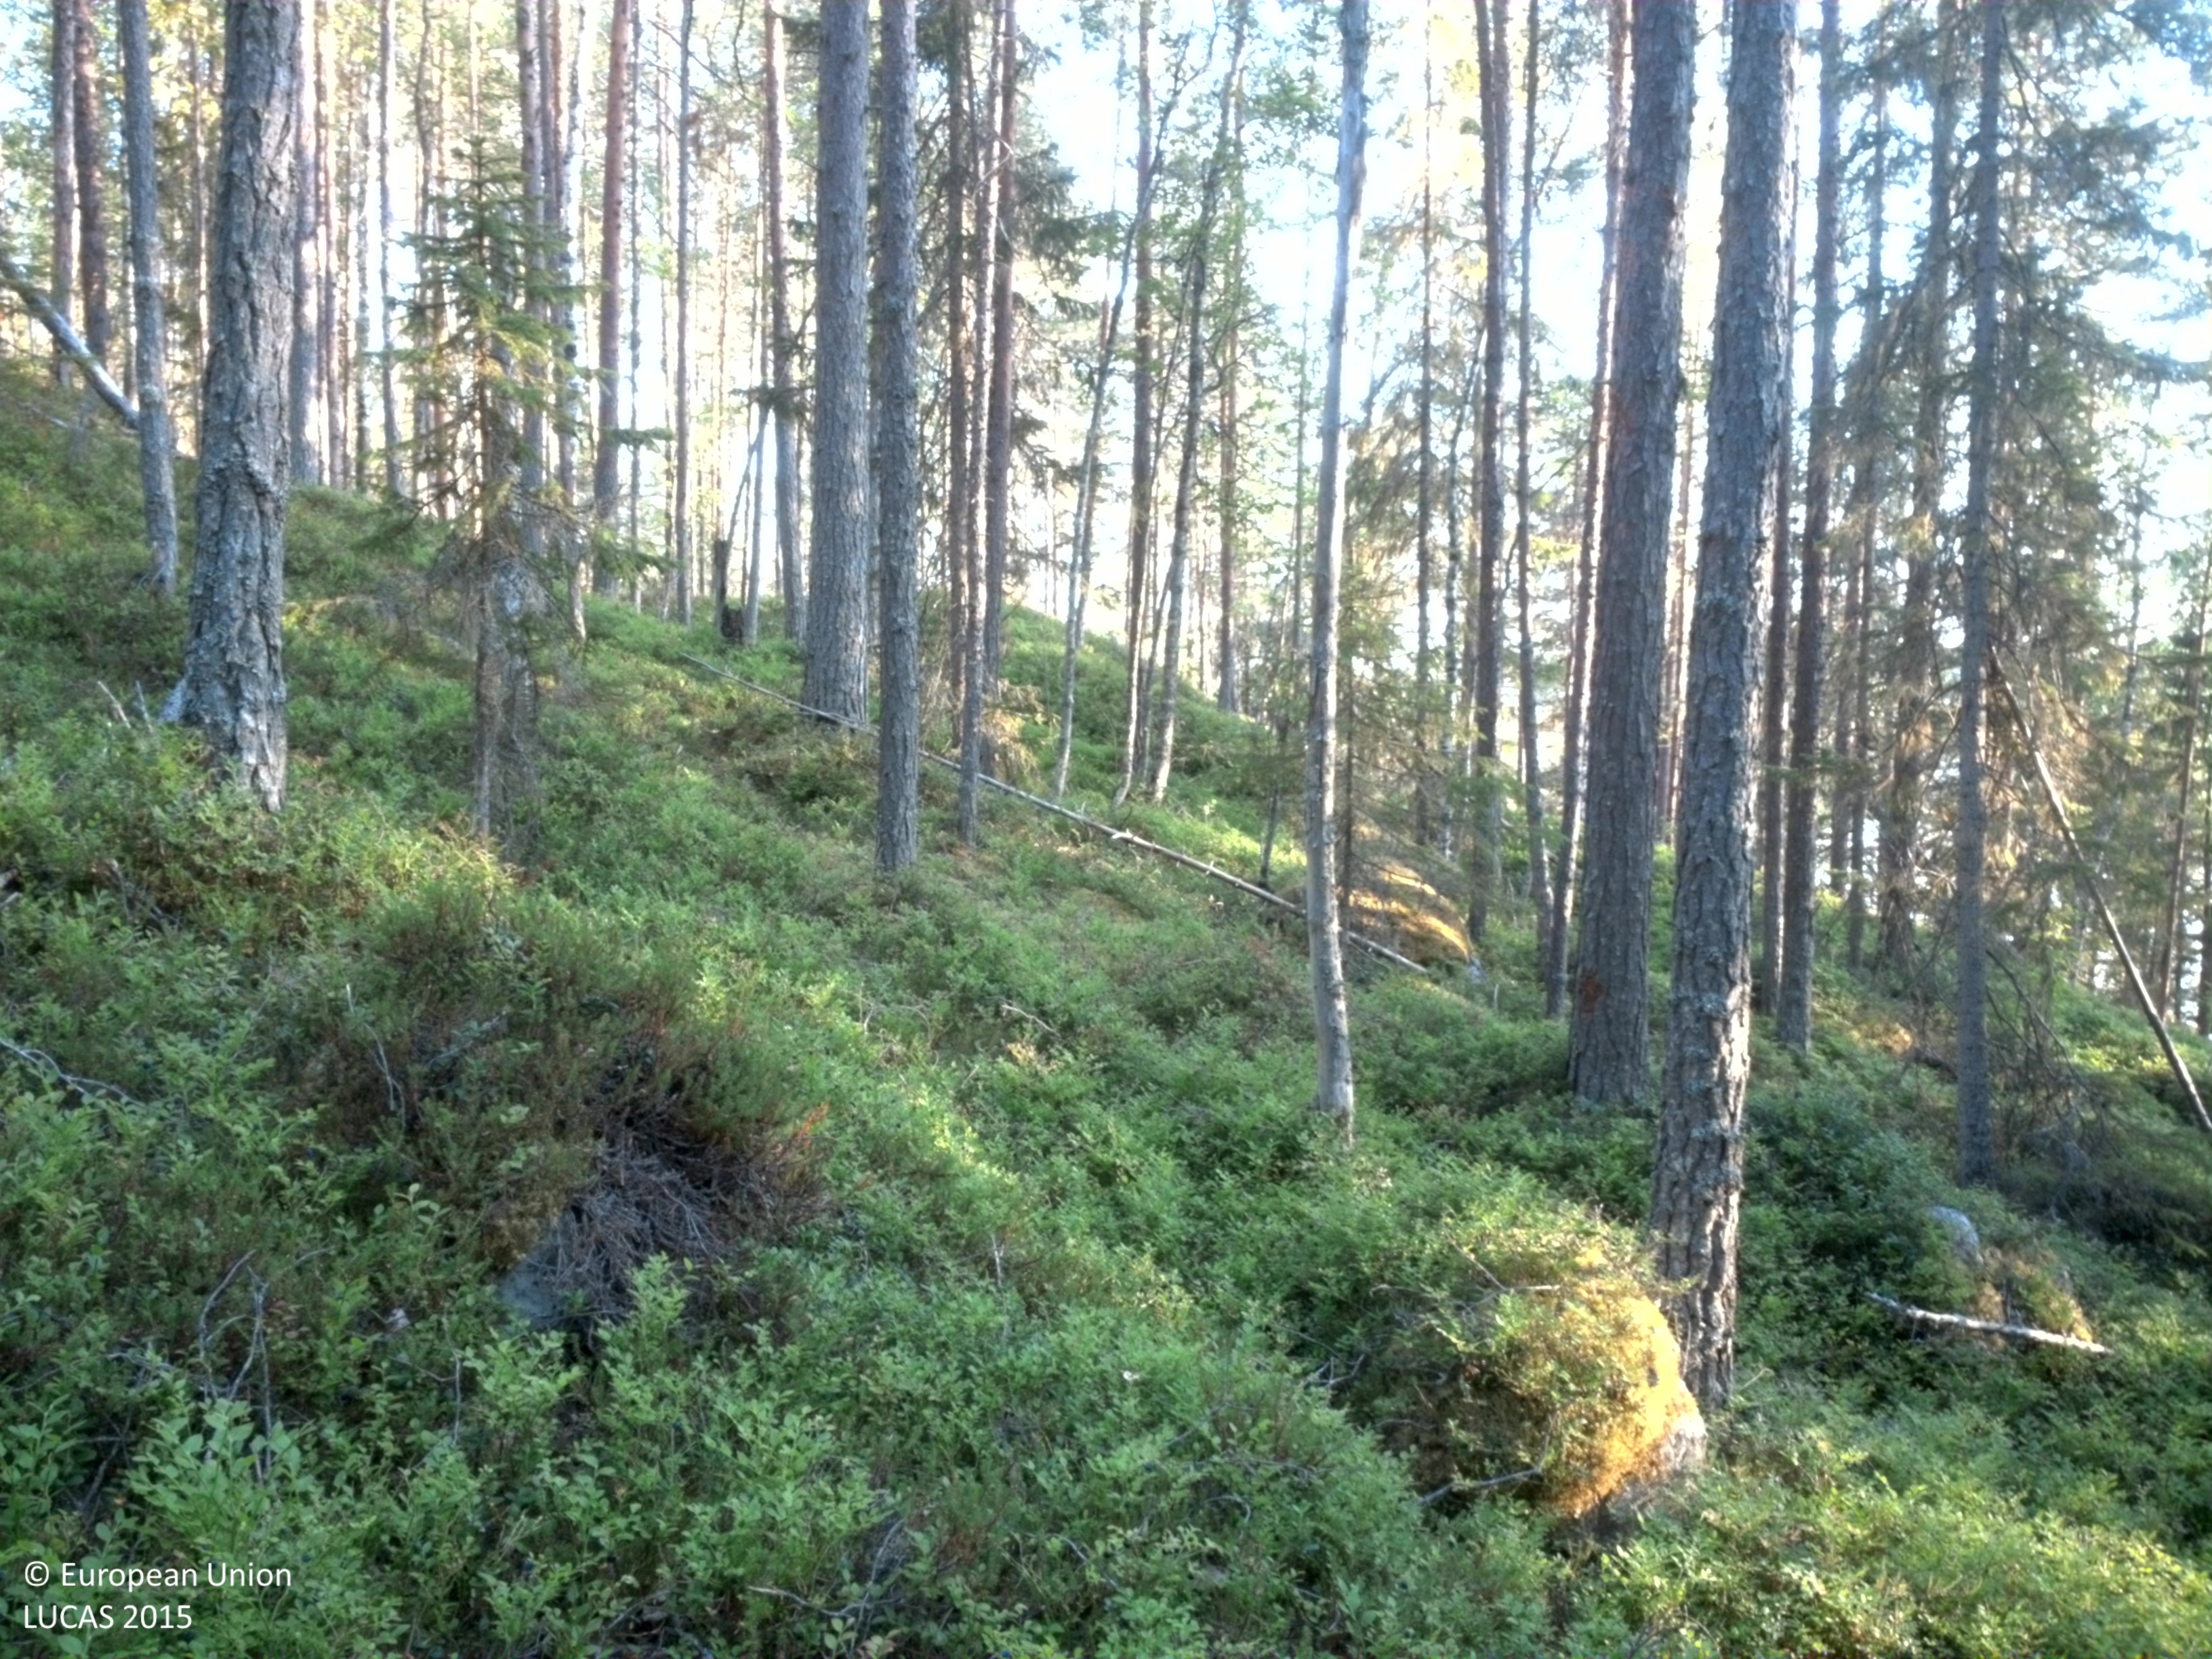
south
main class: Woodland
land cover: Pine dominated coniferous woodland
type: boreal forest
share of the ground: 25 - 50 %
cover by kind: coniferous forest trees 50 %, shrubs 50 %
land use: Forestry
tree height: > 5 m
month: August
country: SE
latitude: 64.4666
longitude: 19.0568
